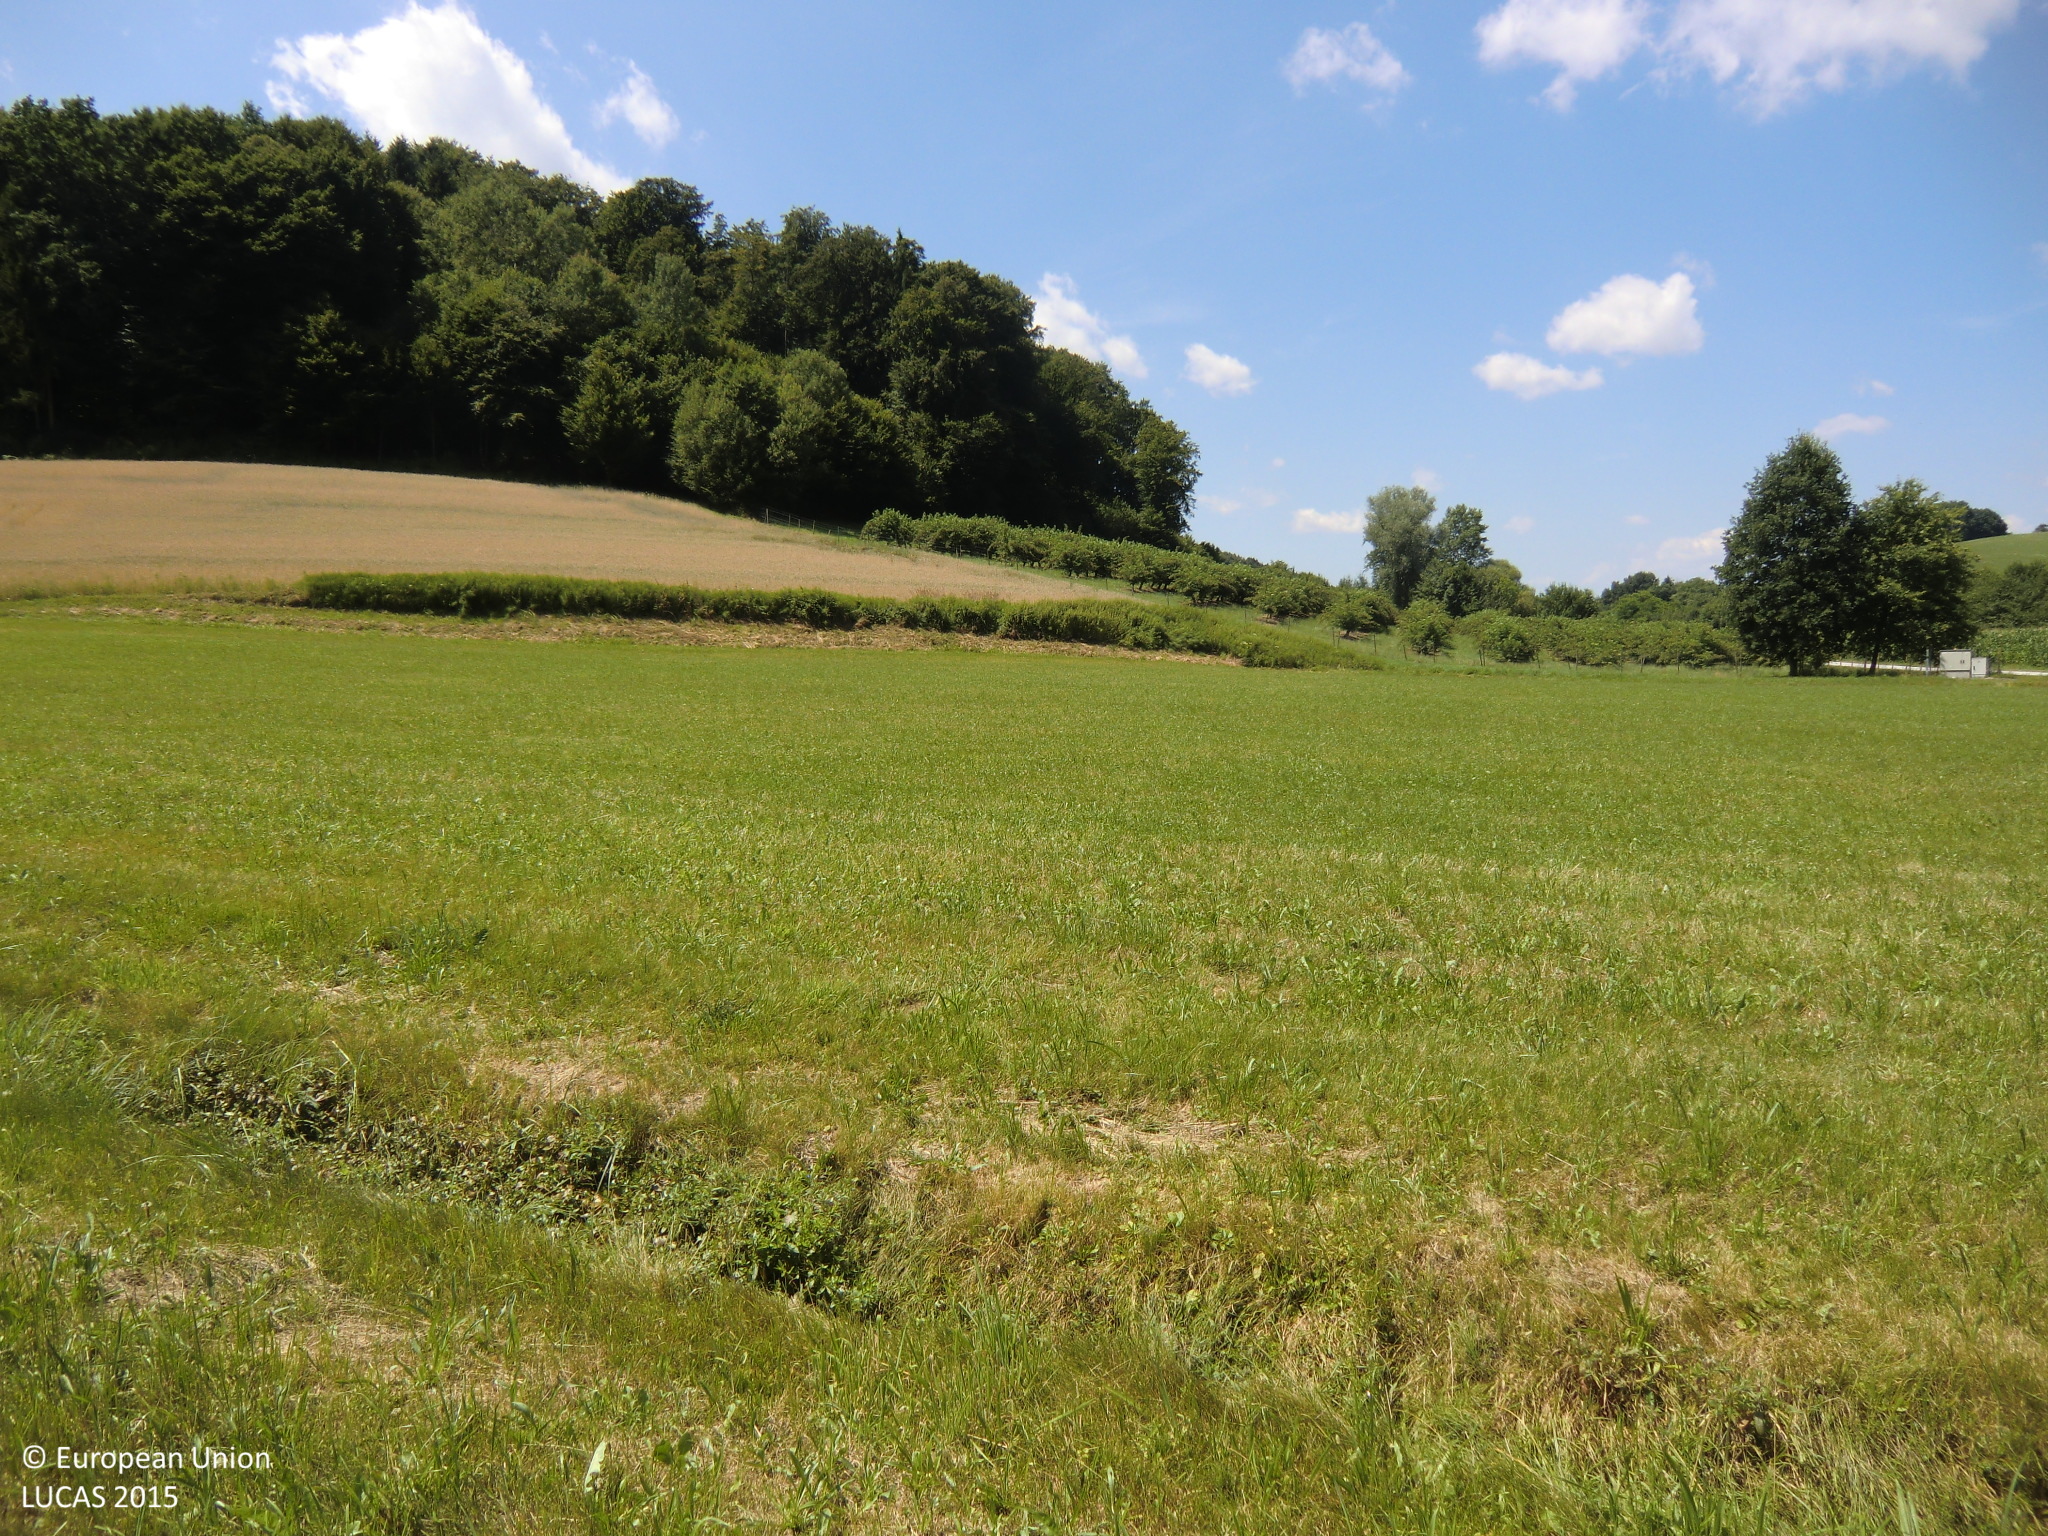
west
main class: Grassland
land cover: Grassland without tree/shrub cover
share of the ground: > 75 %
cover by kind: herbaceous plants 90 %, unconsolidated bare surface 10 %
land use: Agriculture (excluding fallow land and kitchen gardens)
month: July
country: AT
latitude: 46.9588
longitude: 16.0064
